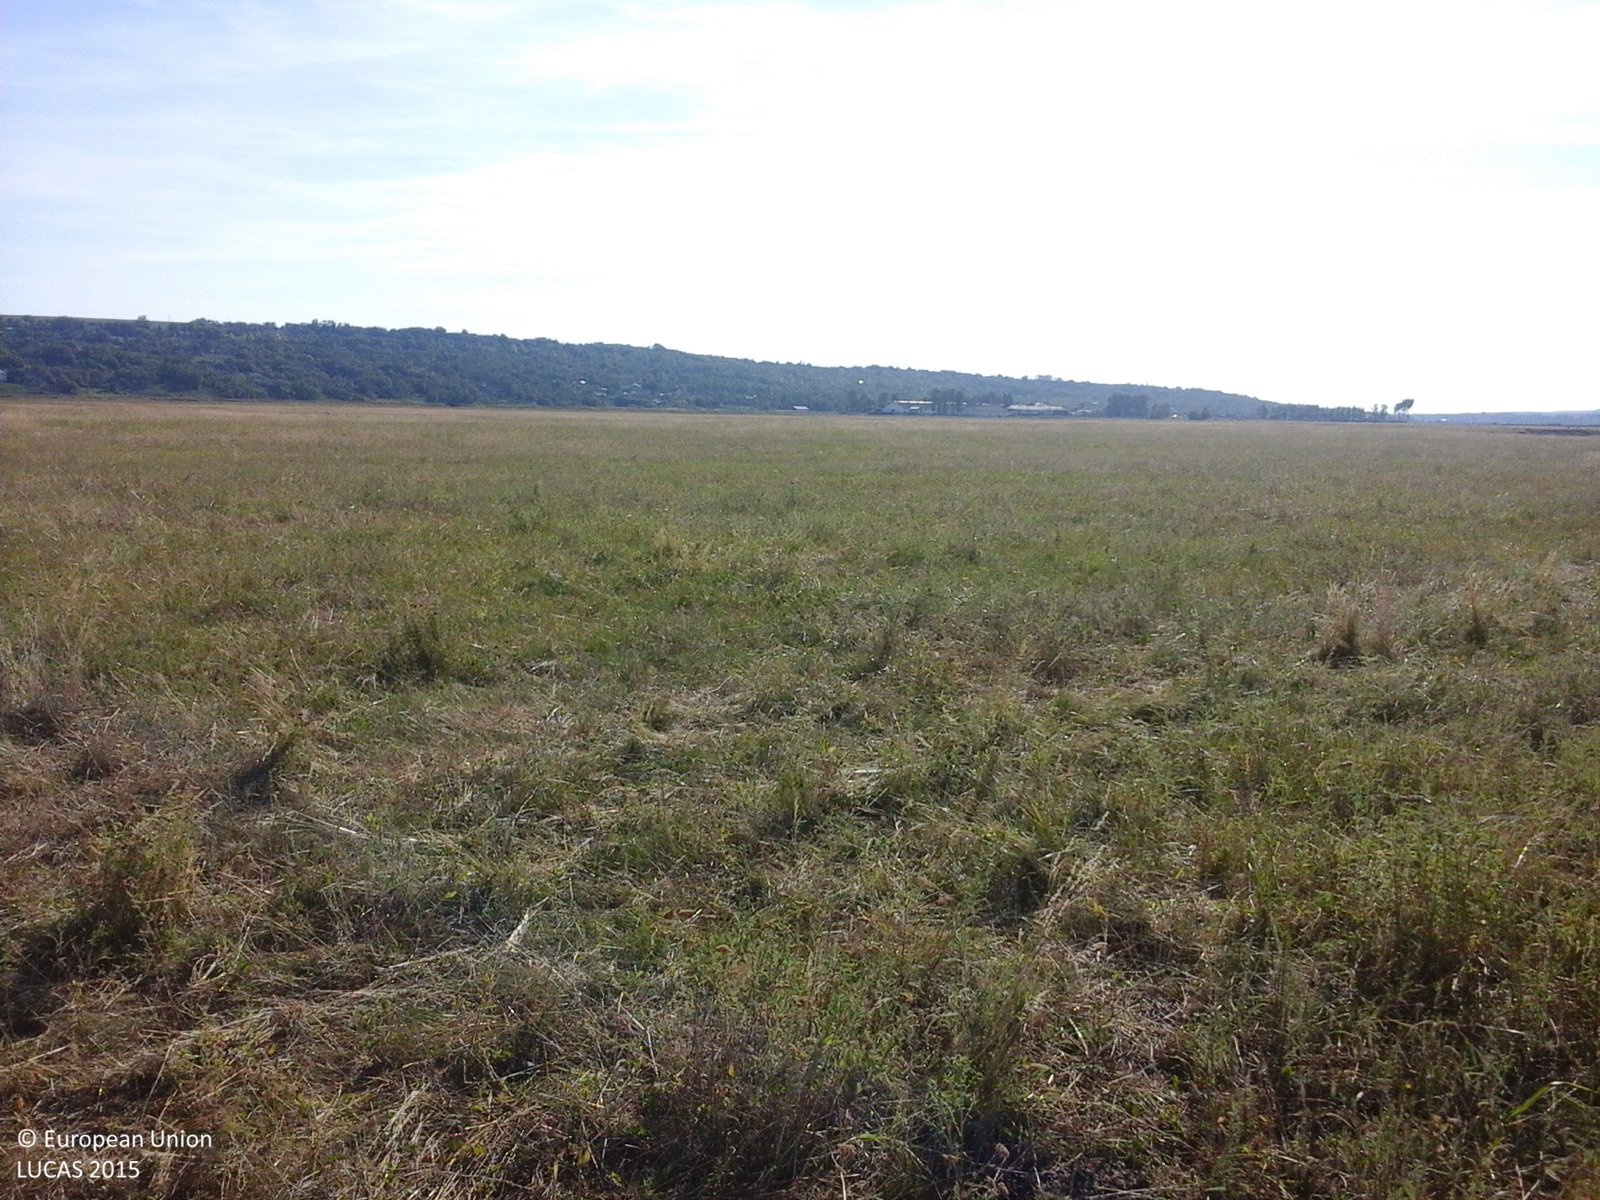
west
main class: Grassland
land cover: Grassland without tree/shrub cover
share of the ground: > 75 %
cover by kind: herbaceous plants 100 %
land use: Agriculture (excluding fallow land and kitchen gardens)
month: June
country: RO
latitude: 47.5981
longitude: 27.1728
